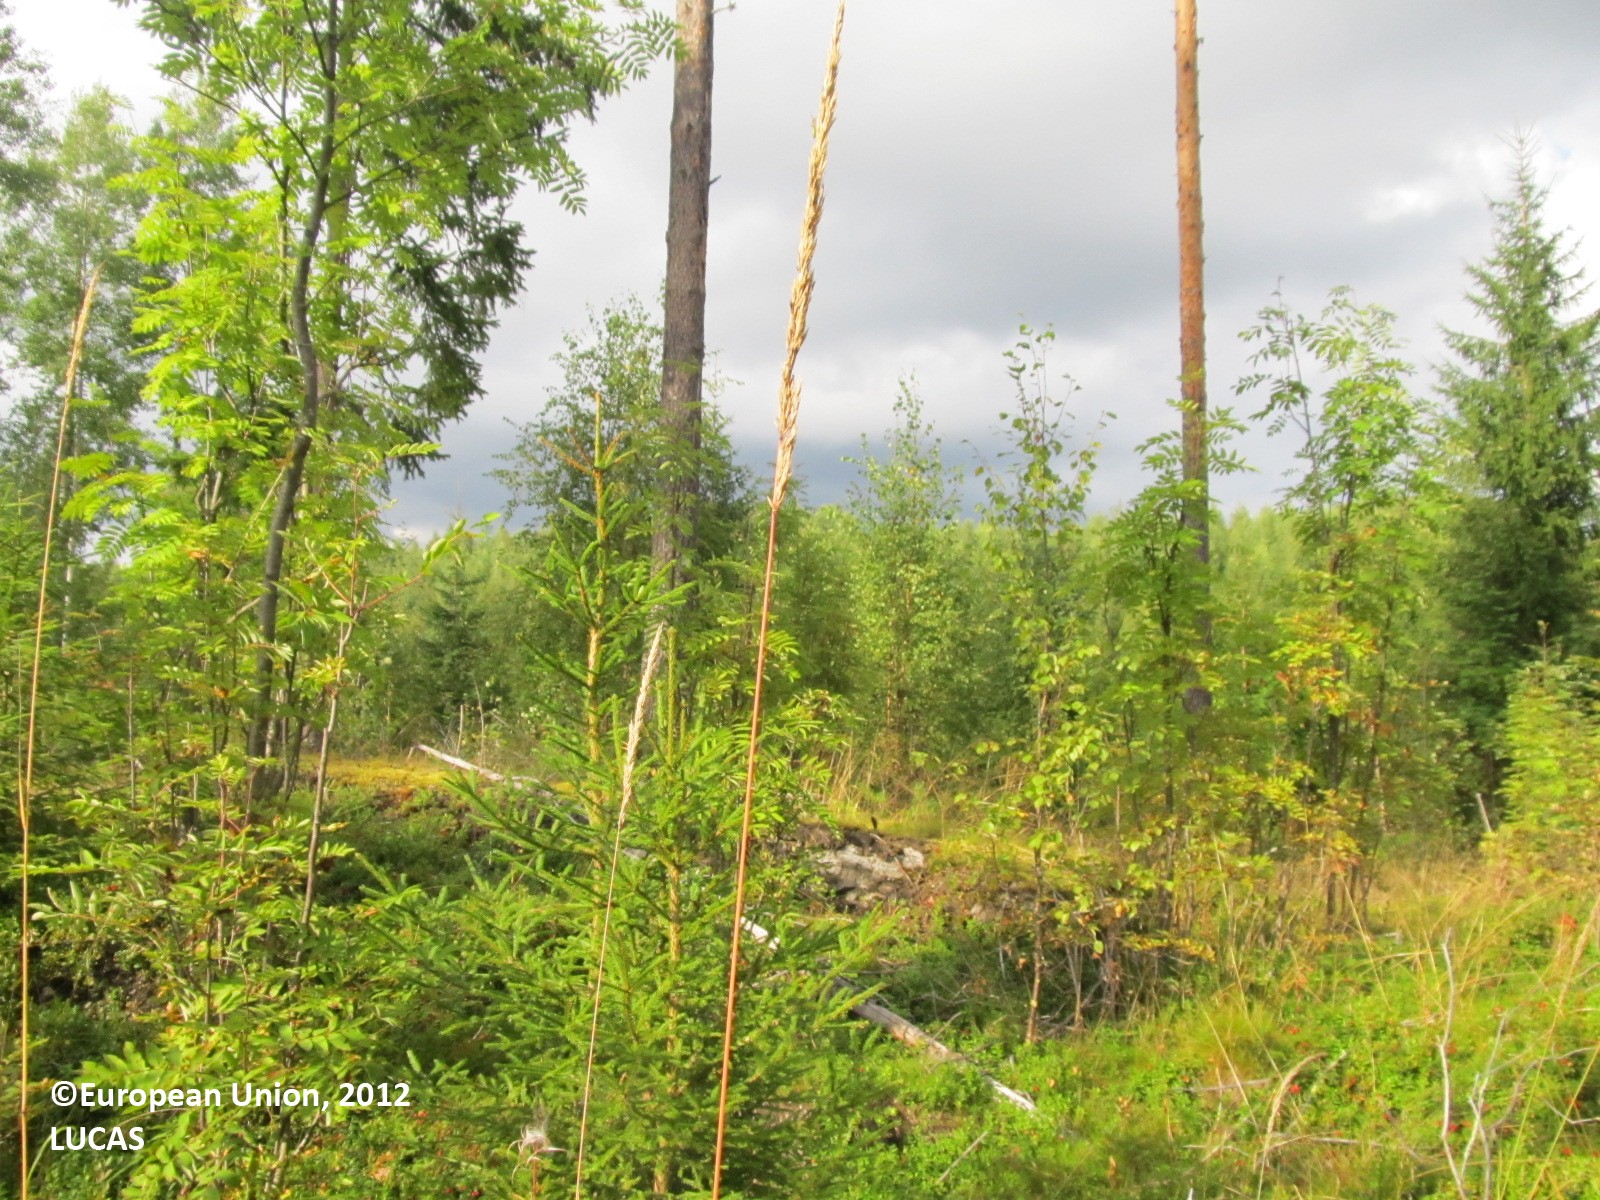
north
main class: Woodland
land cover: Pine dominated mixed woodland
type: boreal forest
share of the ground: 25 - 50 %
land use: Forestry
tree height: > 5 m
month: August
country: FI
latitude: 61.9193
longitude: 27.5621
